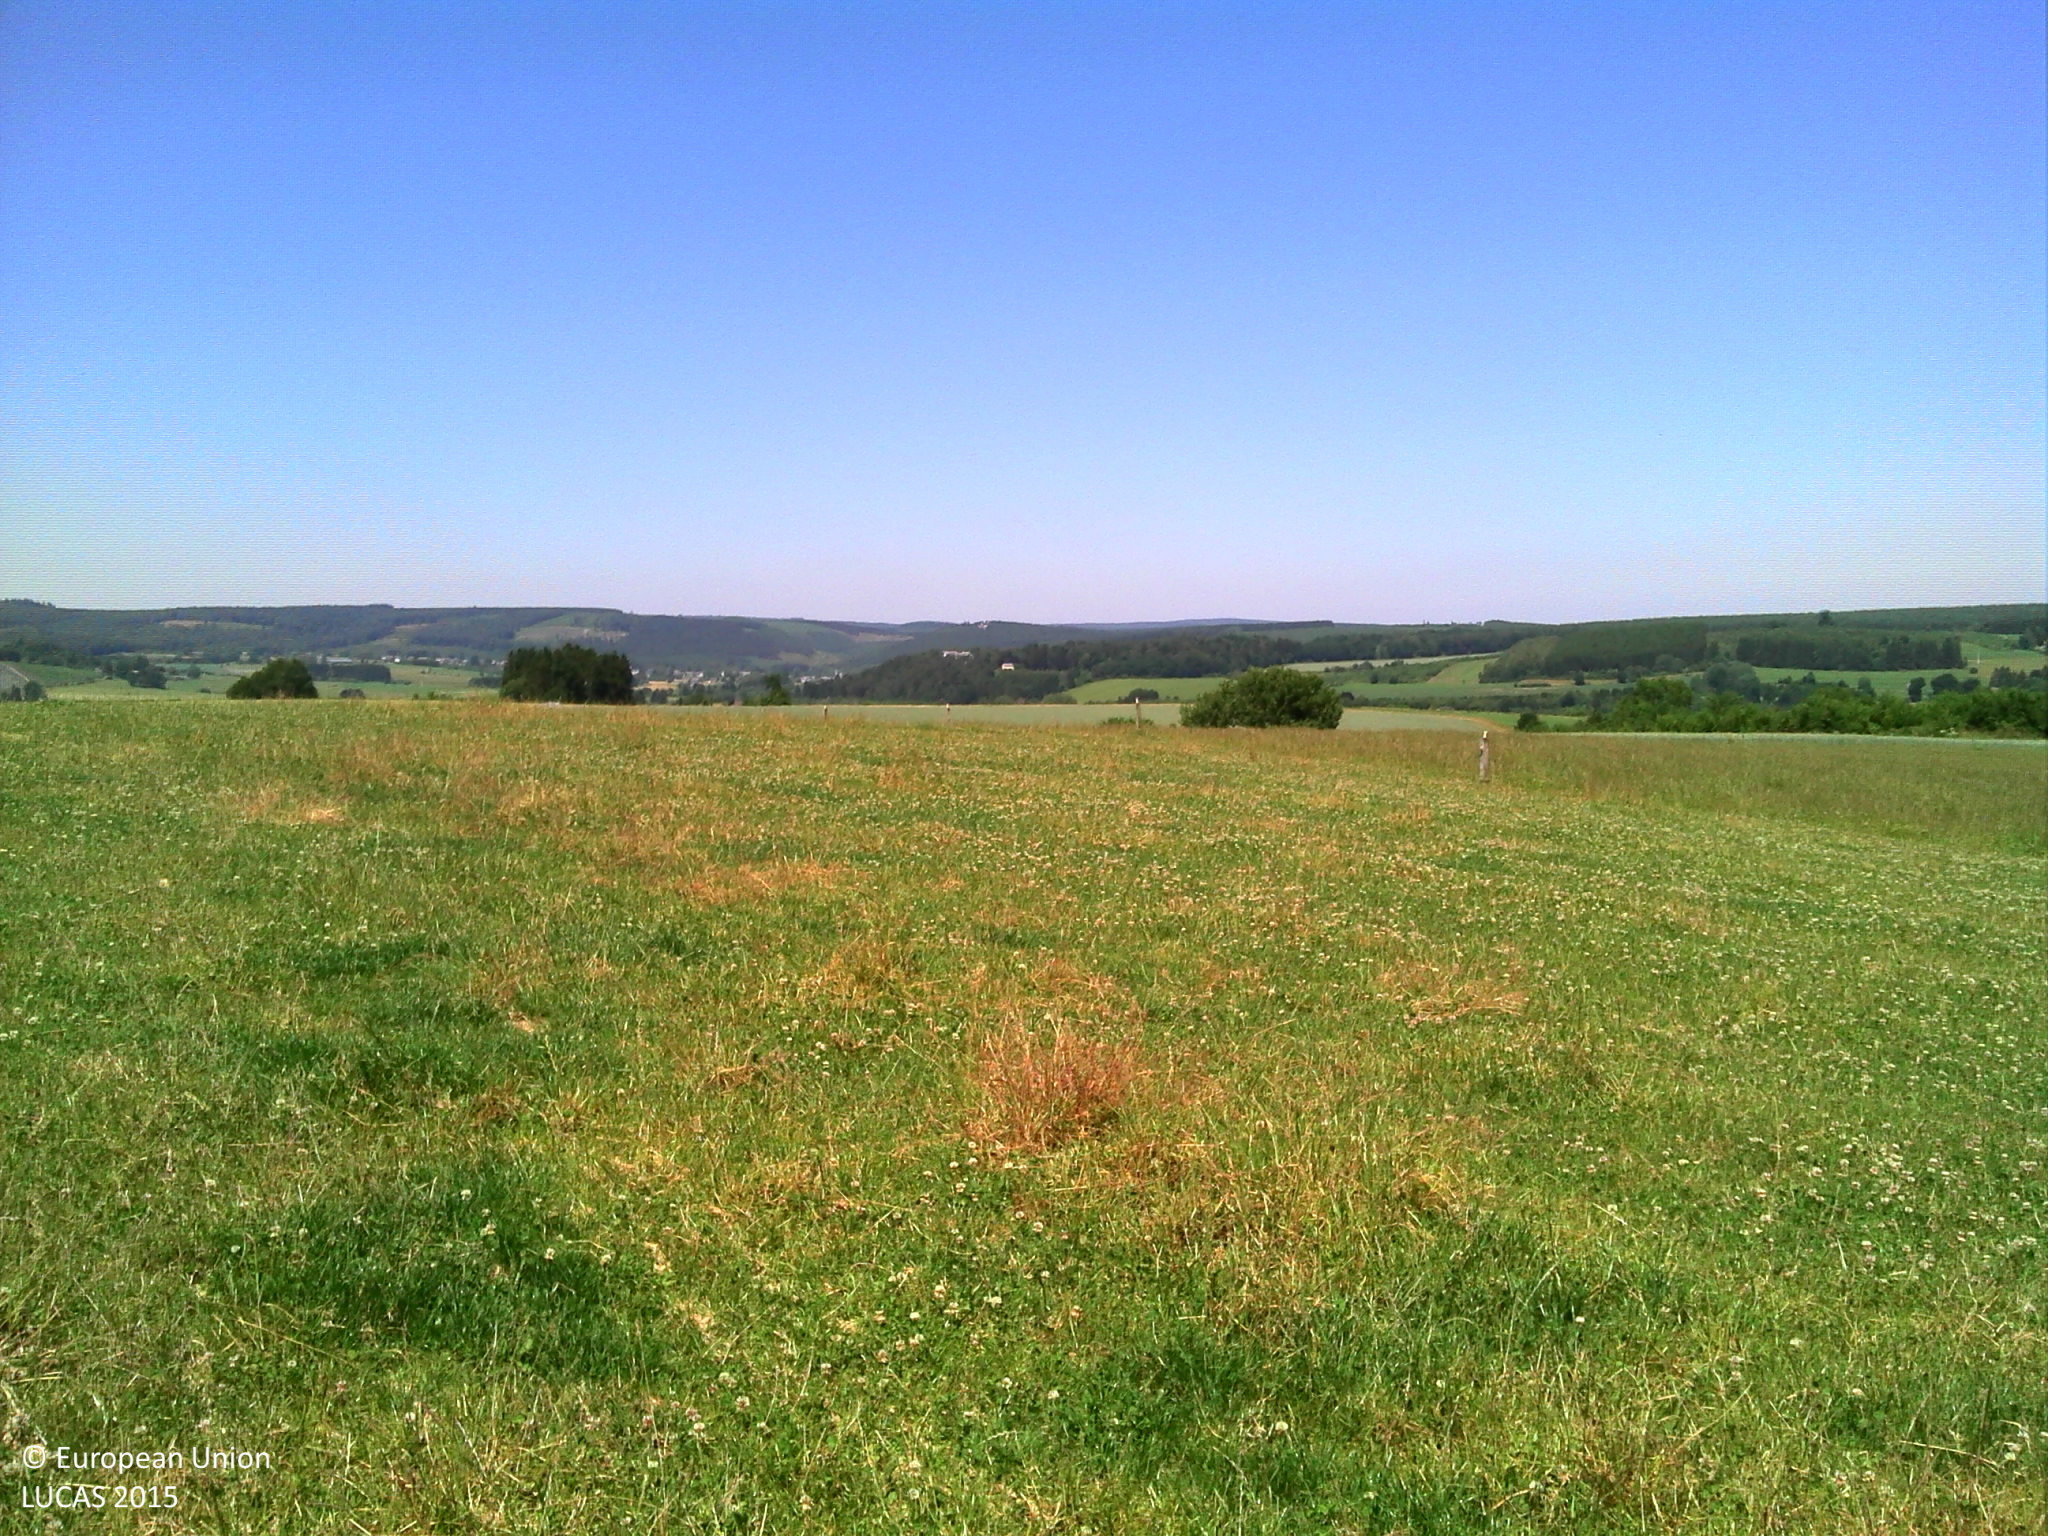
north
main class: Grassland
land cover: Grassland without tree/shrub cover
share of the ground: > 75 %
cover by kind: herbaceous plants 100 %
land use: Agriculture (excluding fallow land and kitchen gardens)
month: June
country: BE
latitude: 50.0252
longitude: 5.5457
